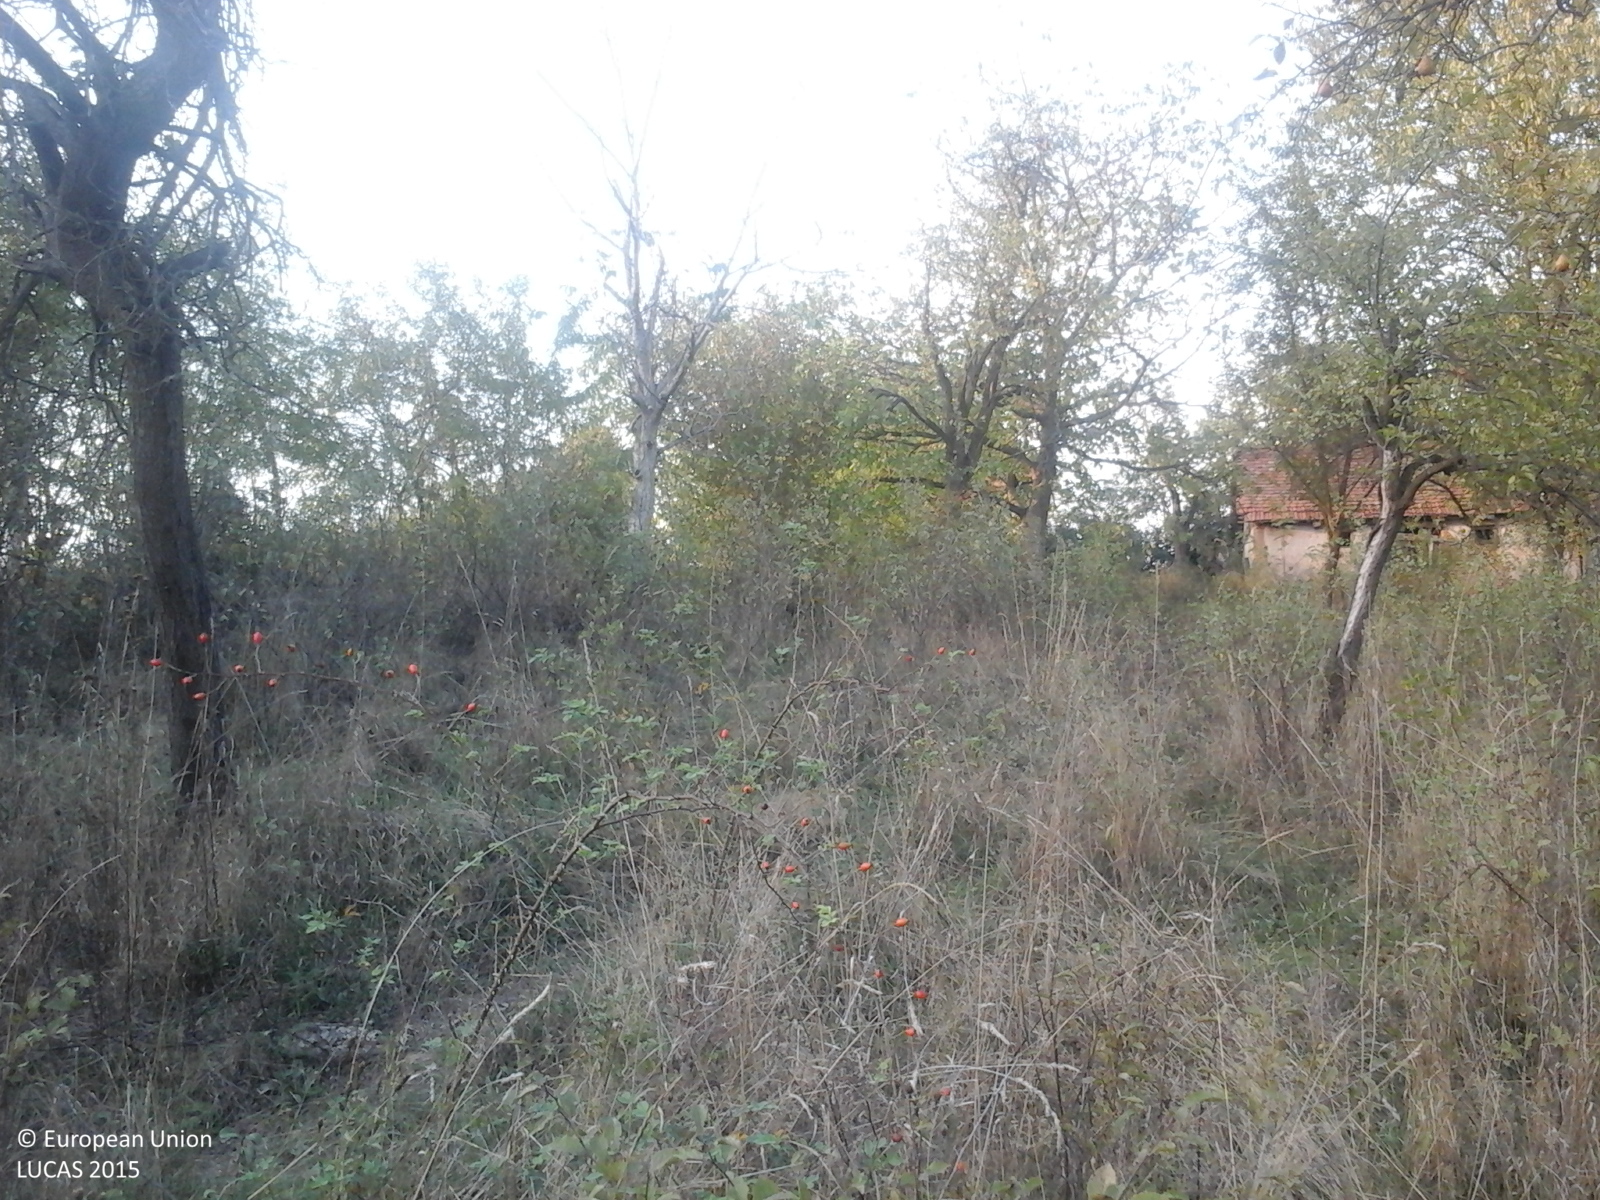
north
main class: Cropland
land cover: Other fruit trees and berries
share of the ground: 50 - 75 %
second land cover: Spontaneously vegetated surfaces
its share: > 75 %
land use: Agriculture (excluding fallow land and kitchen gardens)
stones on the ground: 10 - 25 %
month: September
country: RO
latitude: 45.3216
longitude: 21.8876
